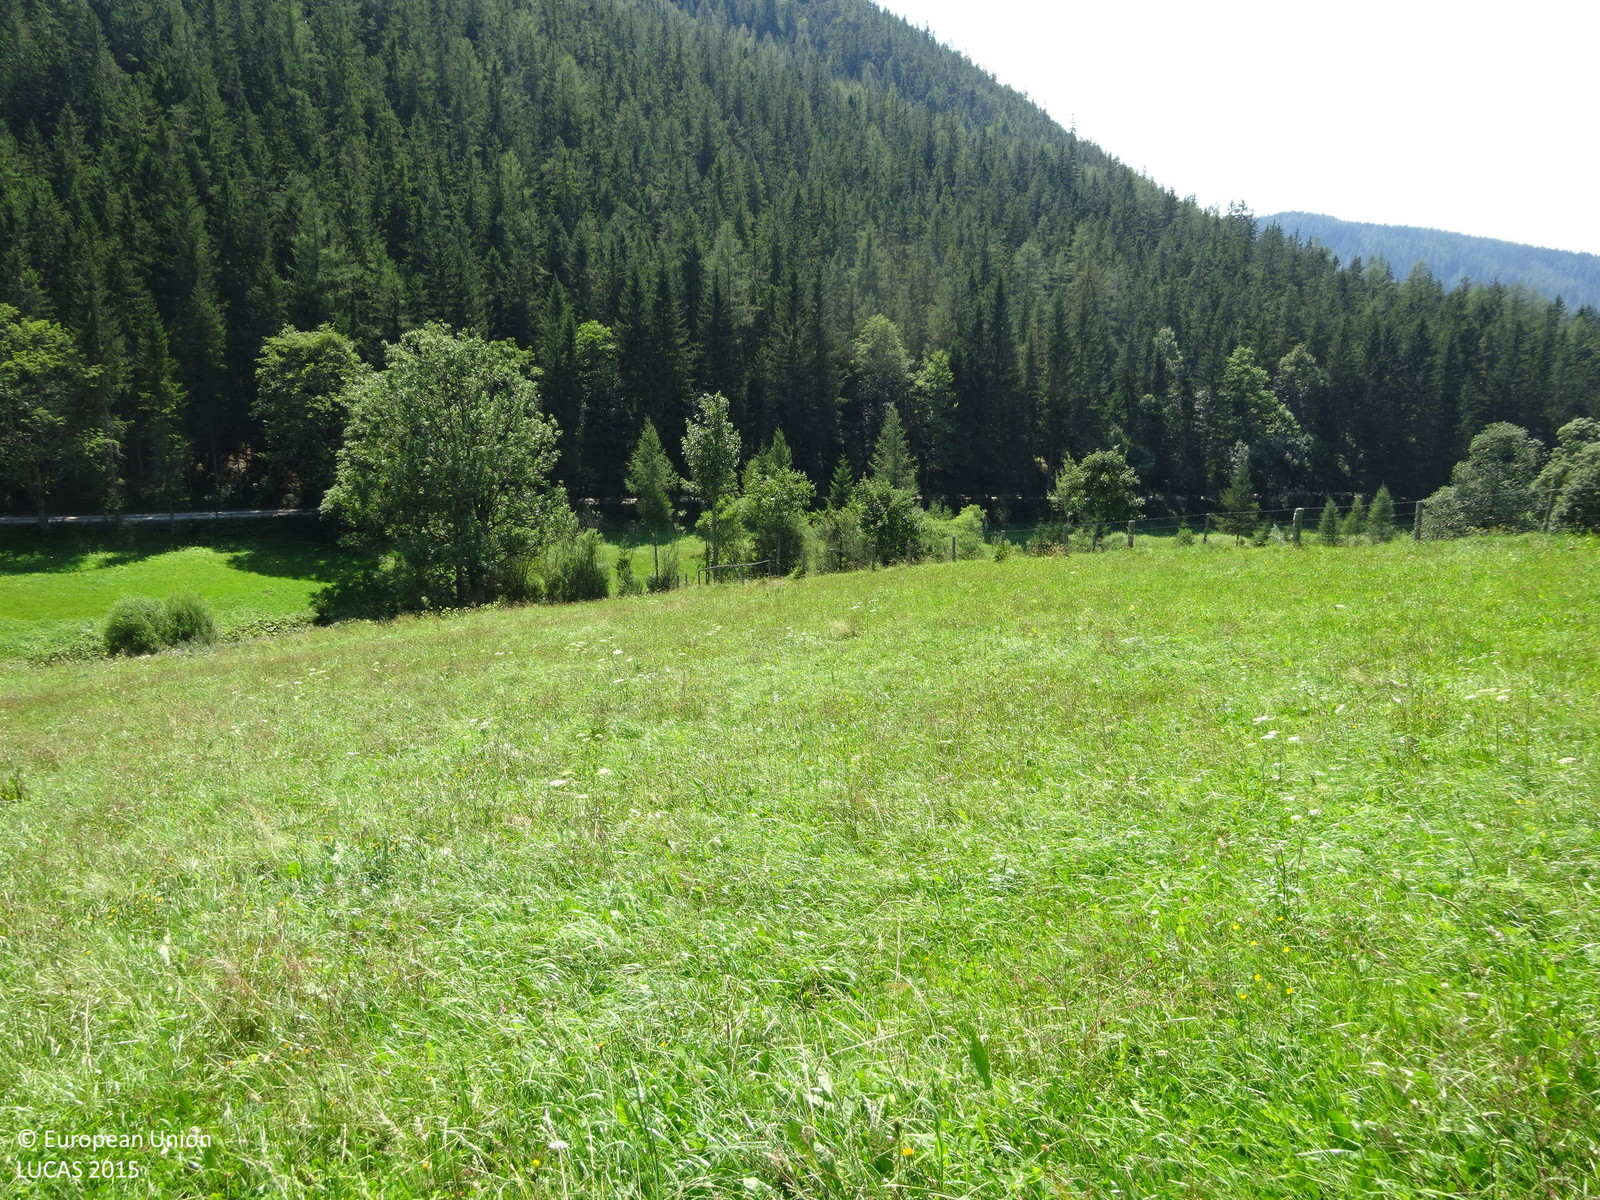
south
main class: Grassland
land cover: Grassland without tree/shrub cover
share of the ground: > 75 %
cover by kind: herbaceous plants 100 %
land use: Agriculture (excluding fallow land and kitchen gardens)
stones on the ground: < 10 %
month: August
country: AT
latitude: 47.5292
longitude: 15.8062
